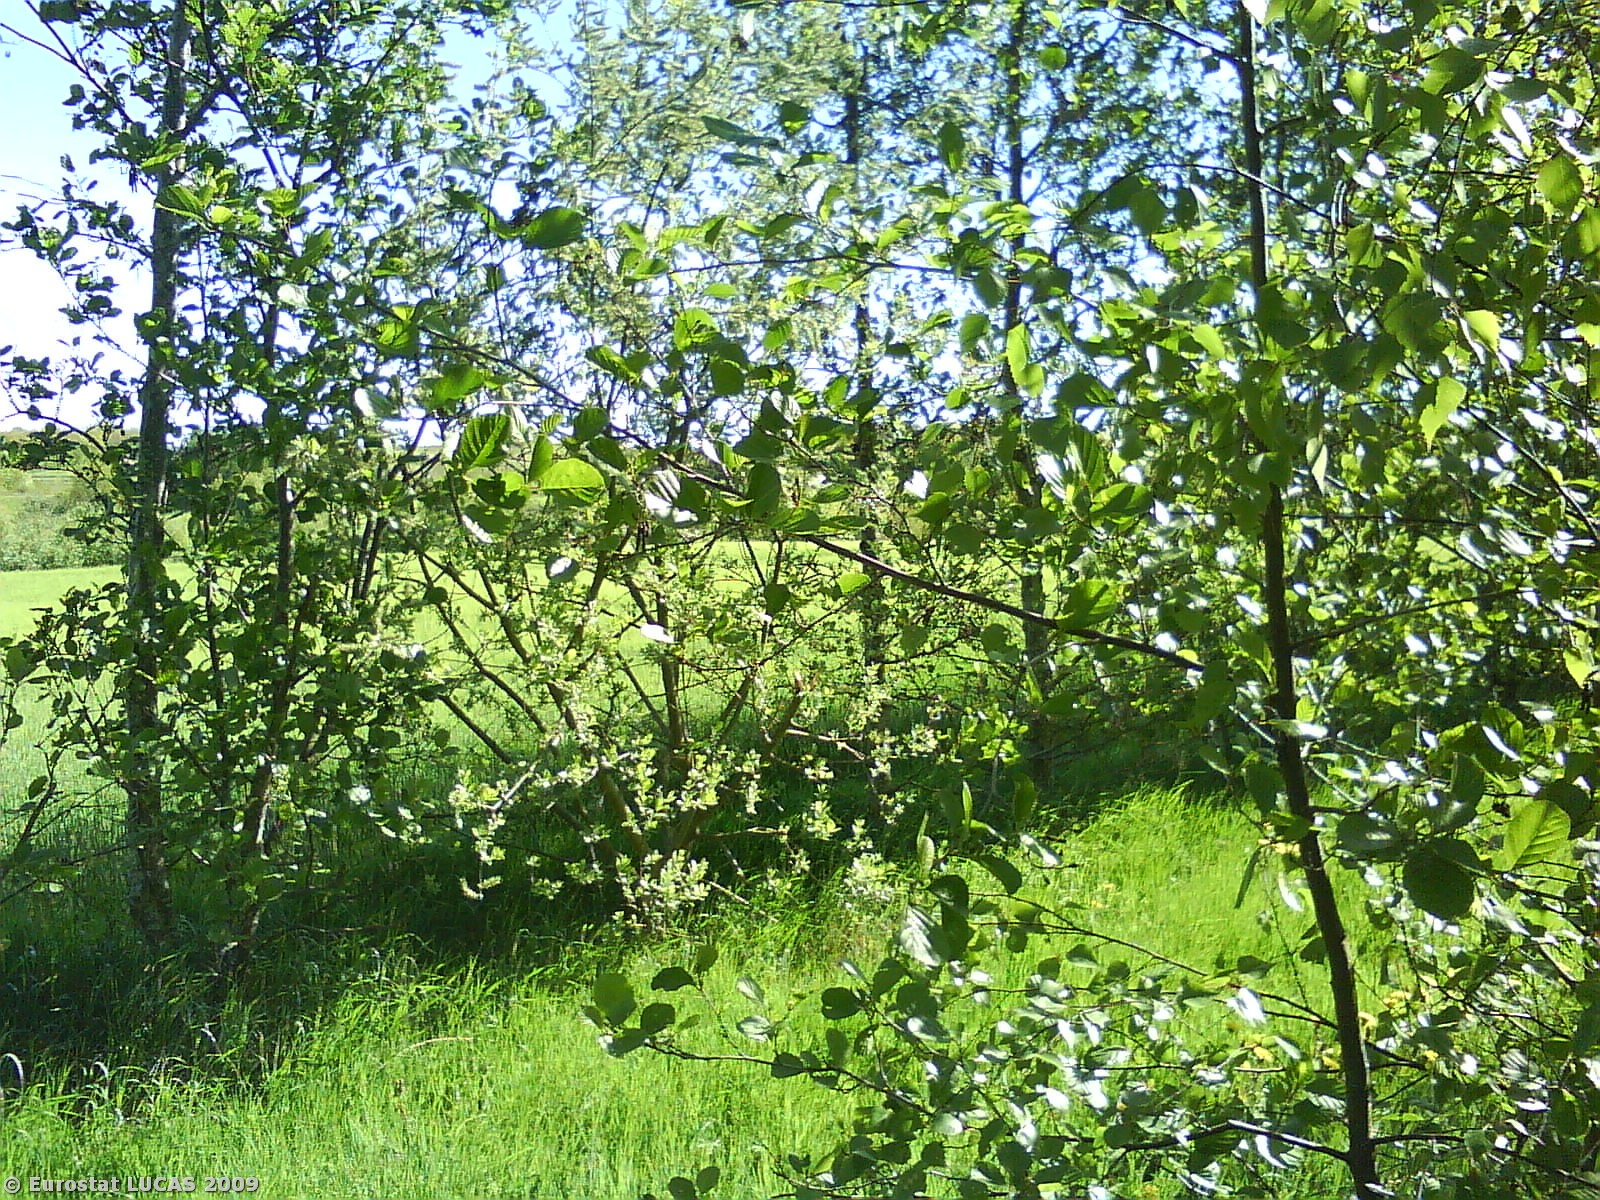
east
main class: Woodland
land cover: Broadleaved woodland
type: plantations and self-sown exotic forest
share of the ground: 25 - 50 %
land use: Unused
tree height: > 5 m
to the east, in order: Broadleaved woodland; Grassland with sparse tree/shrub cover; Managed hedges; Abandoned hedges; Barley; Tracks; Grassland without tree/shrub cover; Abandoned hedges; Fences; Artificial constructions in urban areas
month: May
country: DK
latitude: 56.3473
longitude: 10.7595
